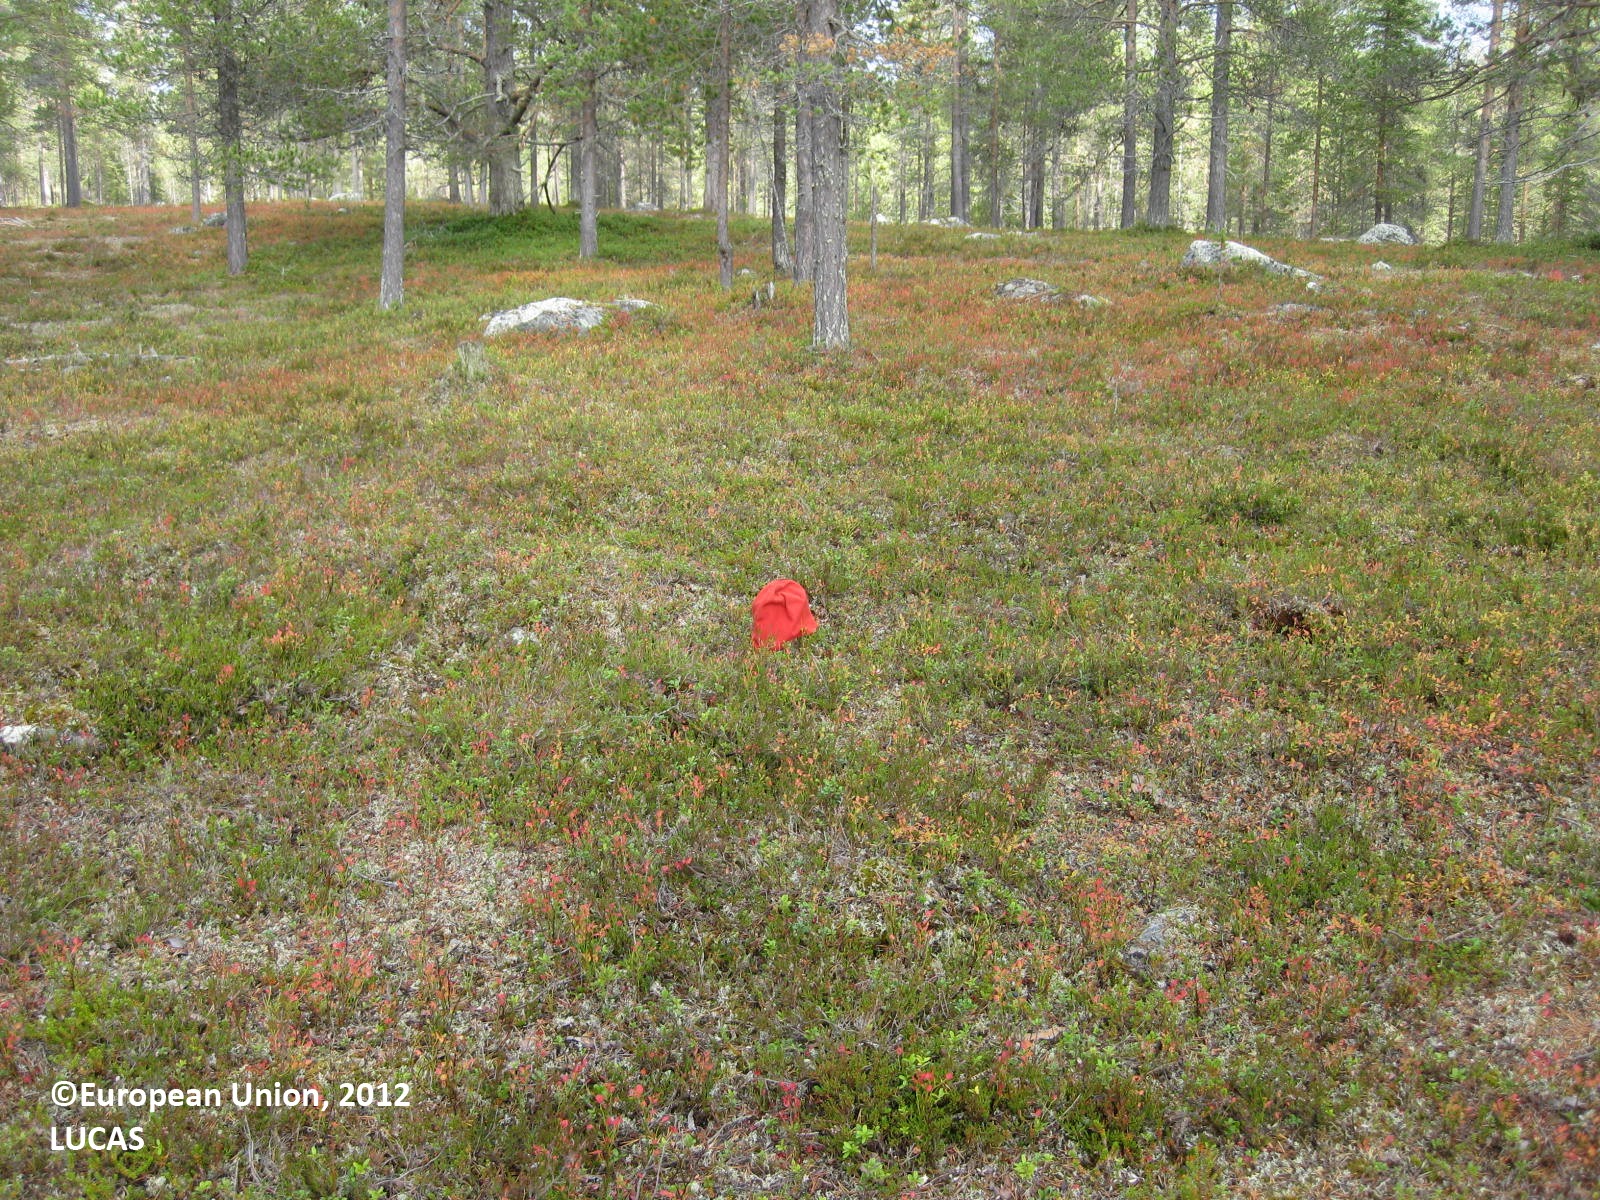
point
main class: Woodland
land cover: Pine dominated coniferous woodland
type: boreal forest
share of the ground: > 75 %
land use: Forestry
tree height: > 5 m
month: September
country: FI
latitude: 68.0120
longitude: 23.5801
